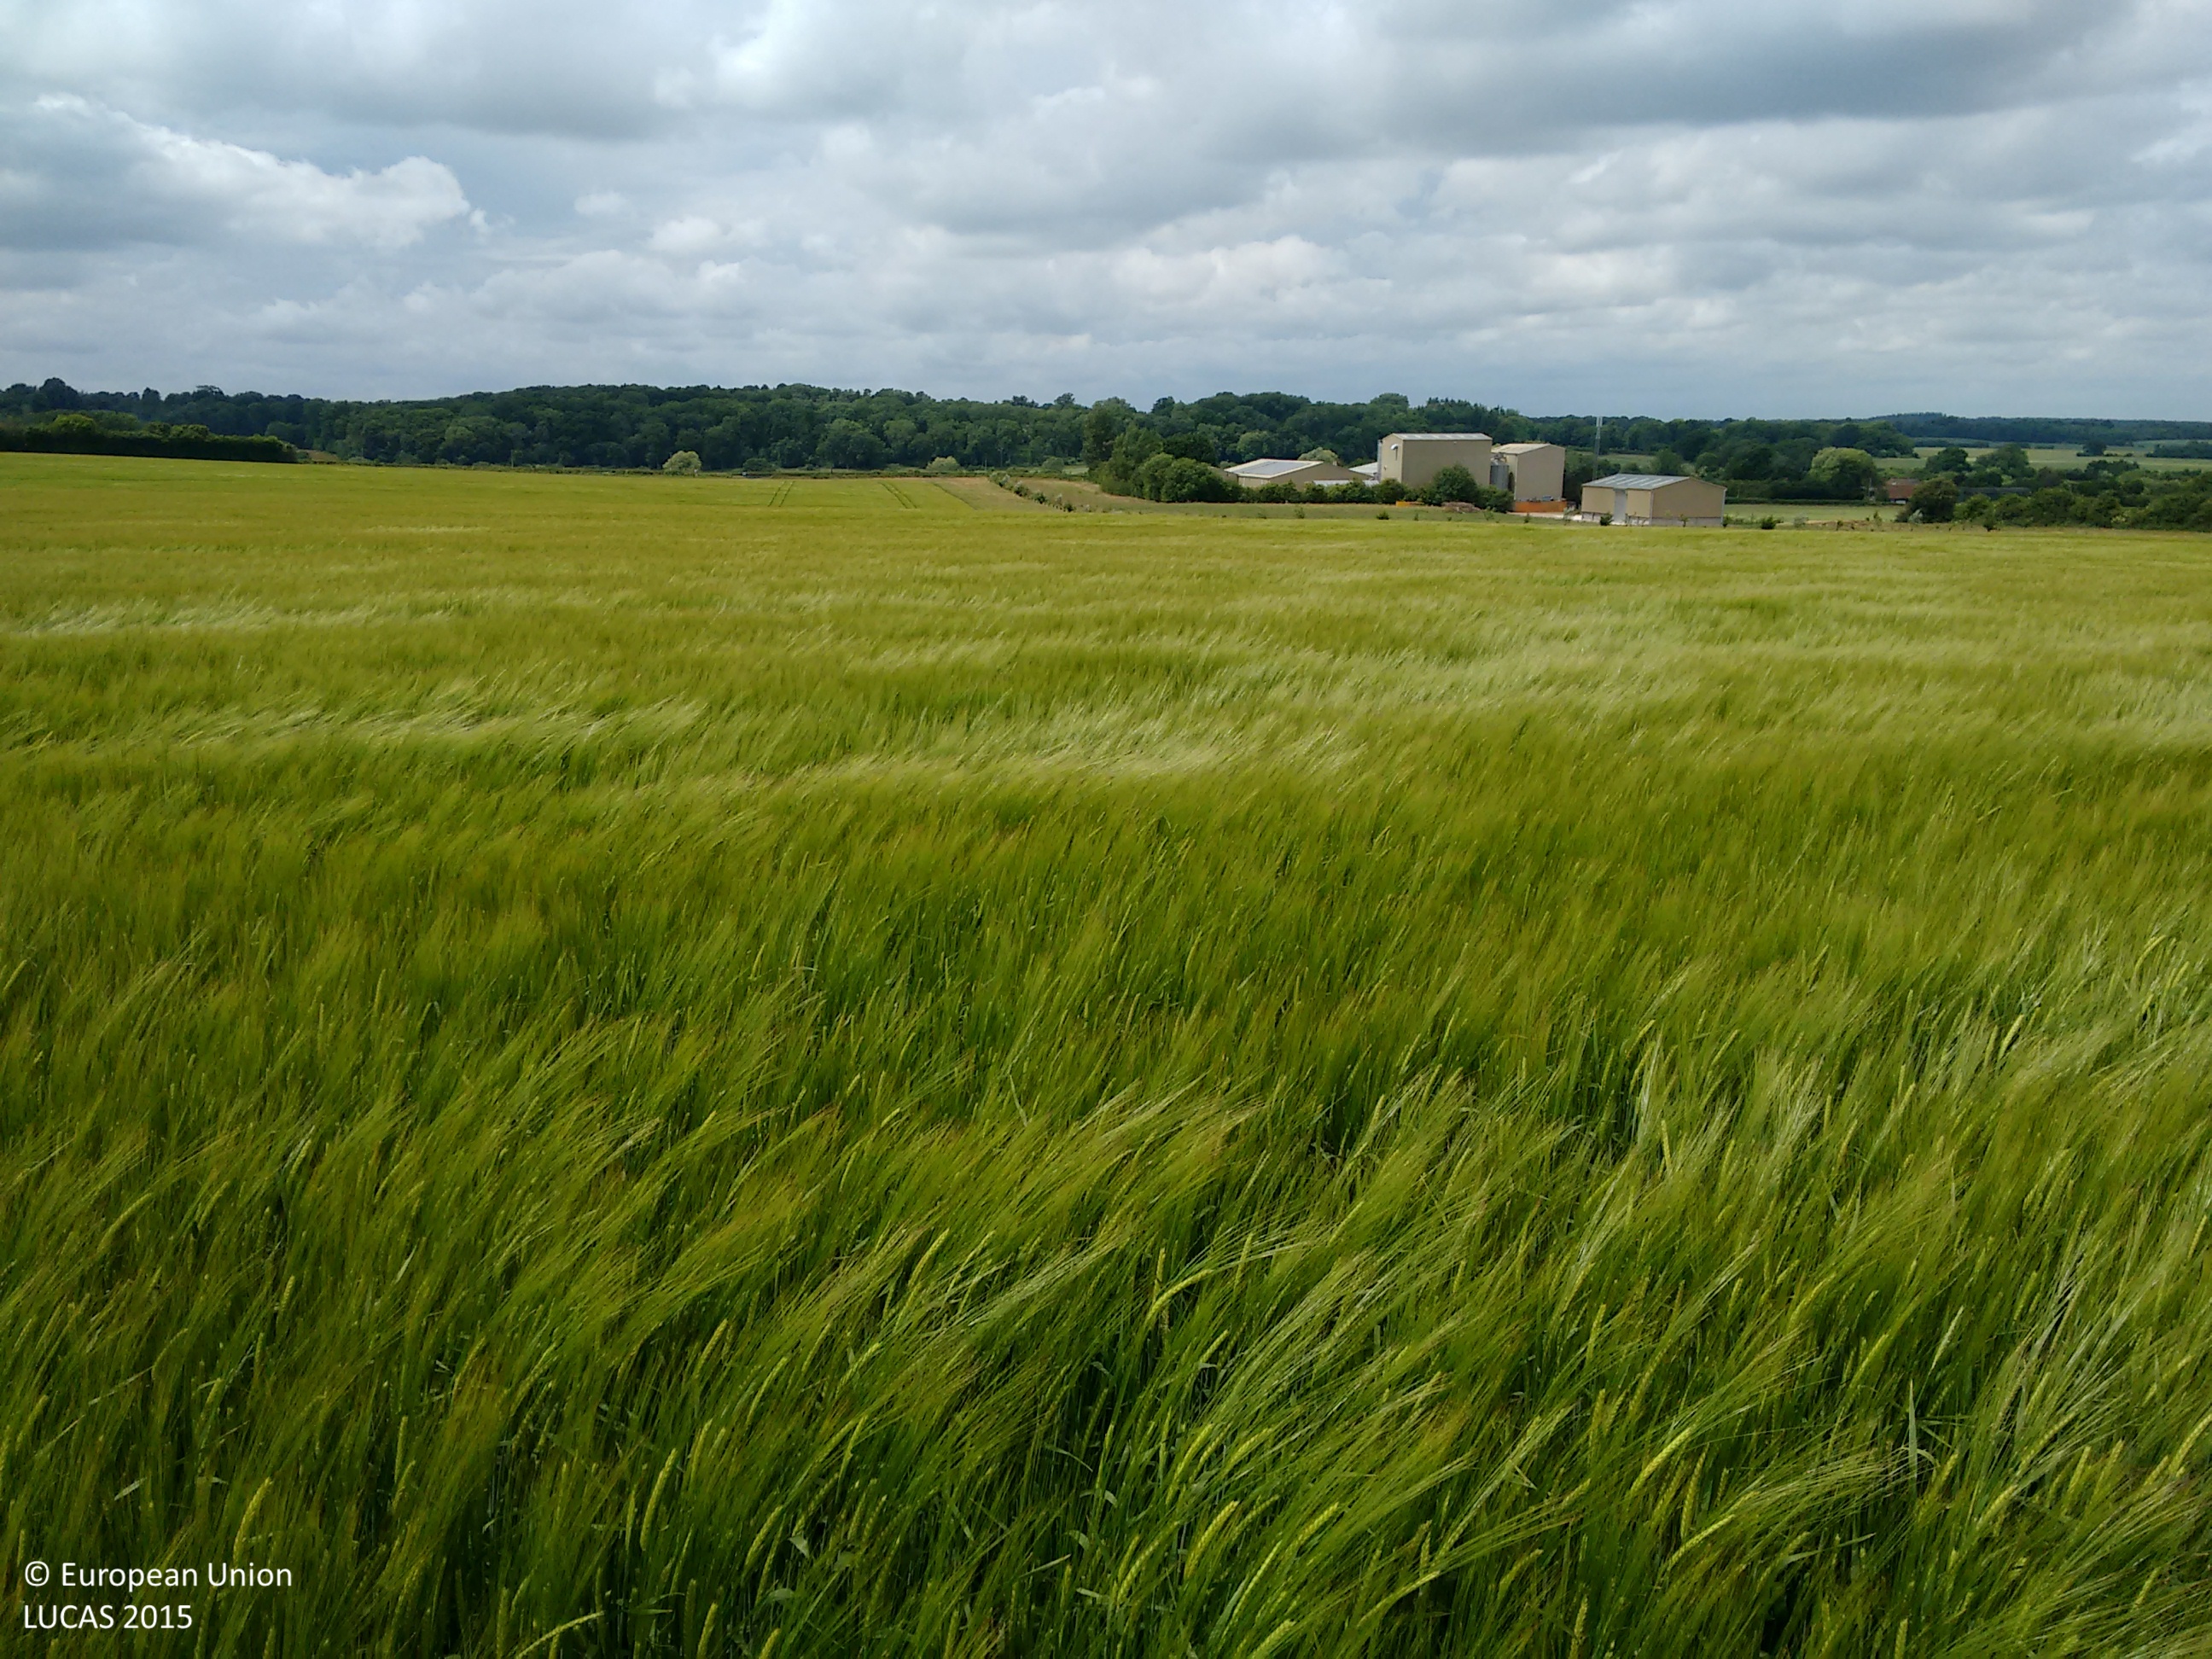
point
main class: Cropland
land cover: Barley
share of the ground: > 75 %
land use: Agriculture (excluding fallow land and kitchen gardens)
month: June
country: GB
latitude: 51.3774
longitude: -1.5307
